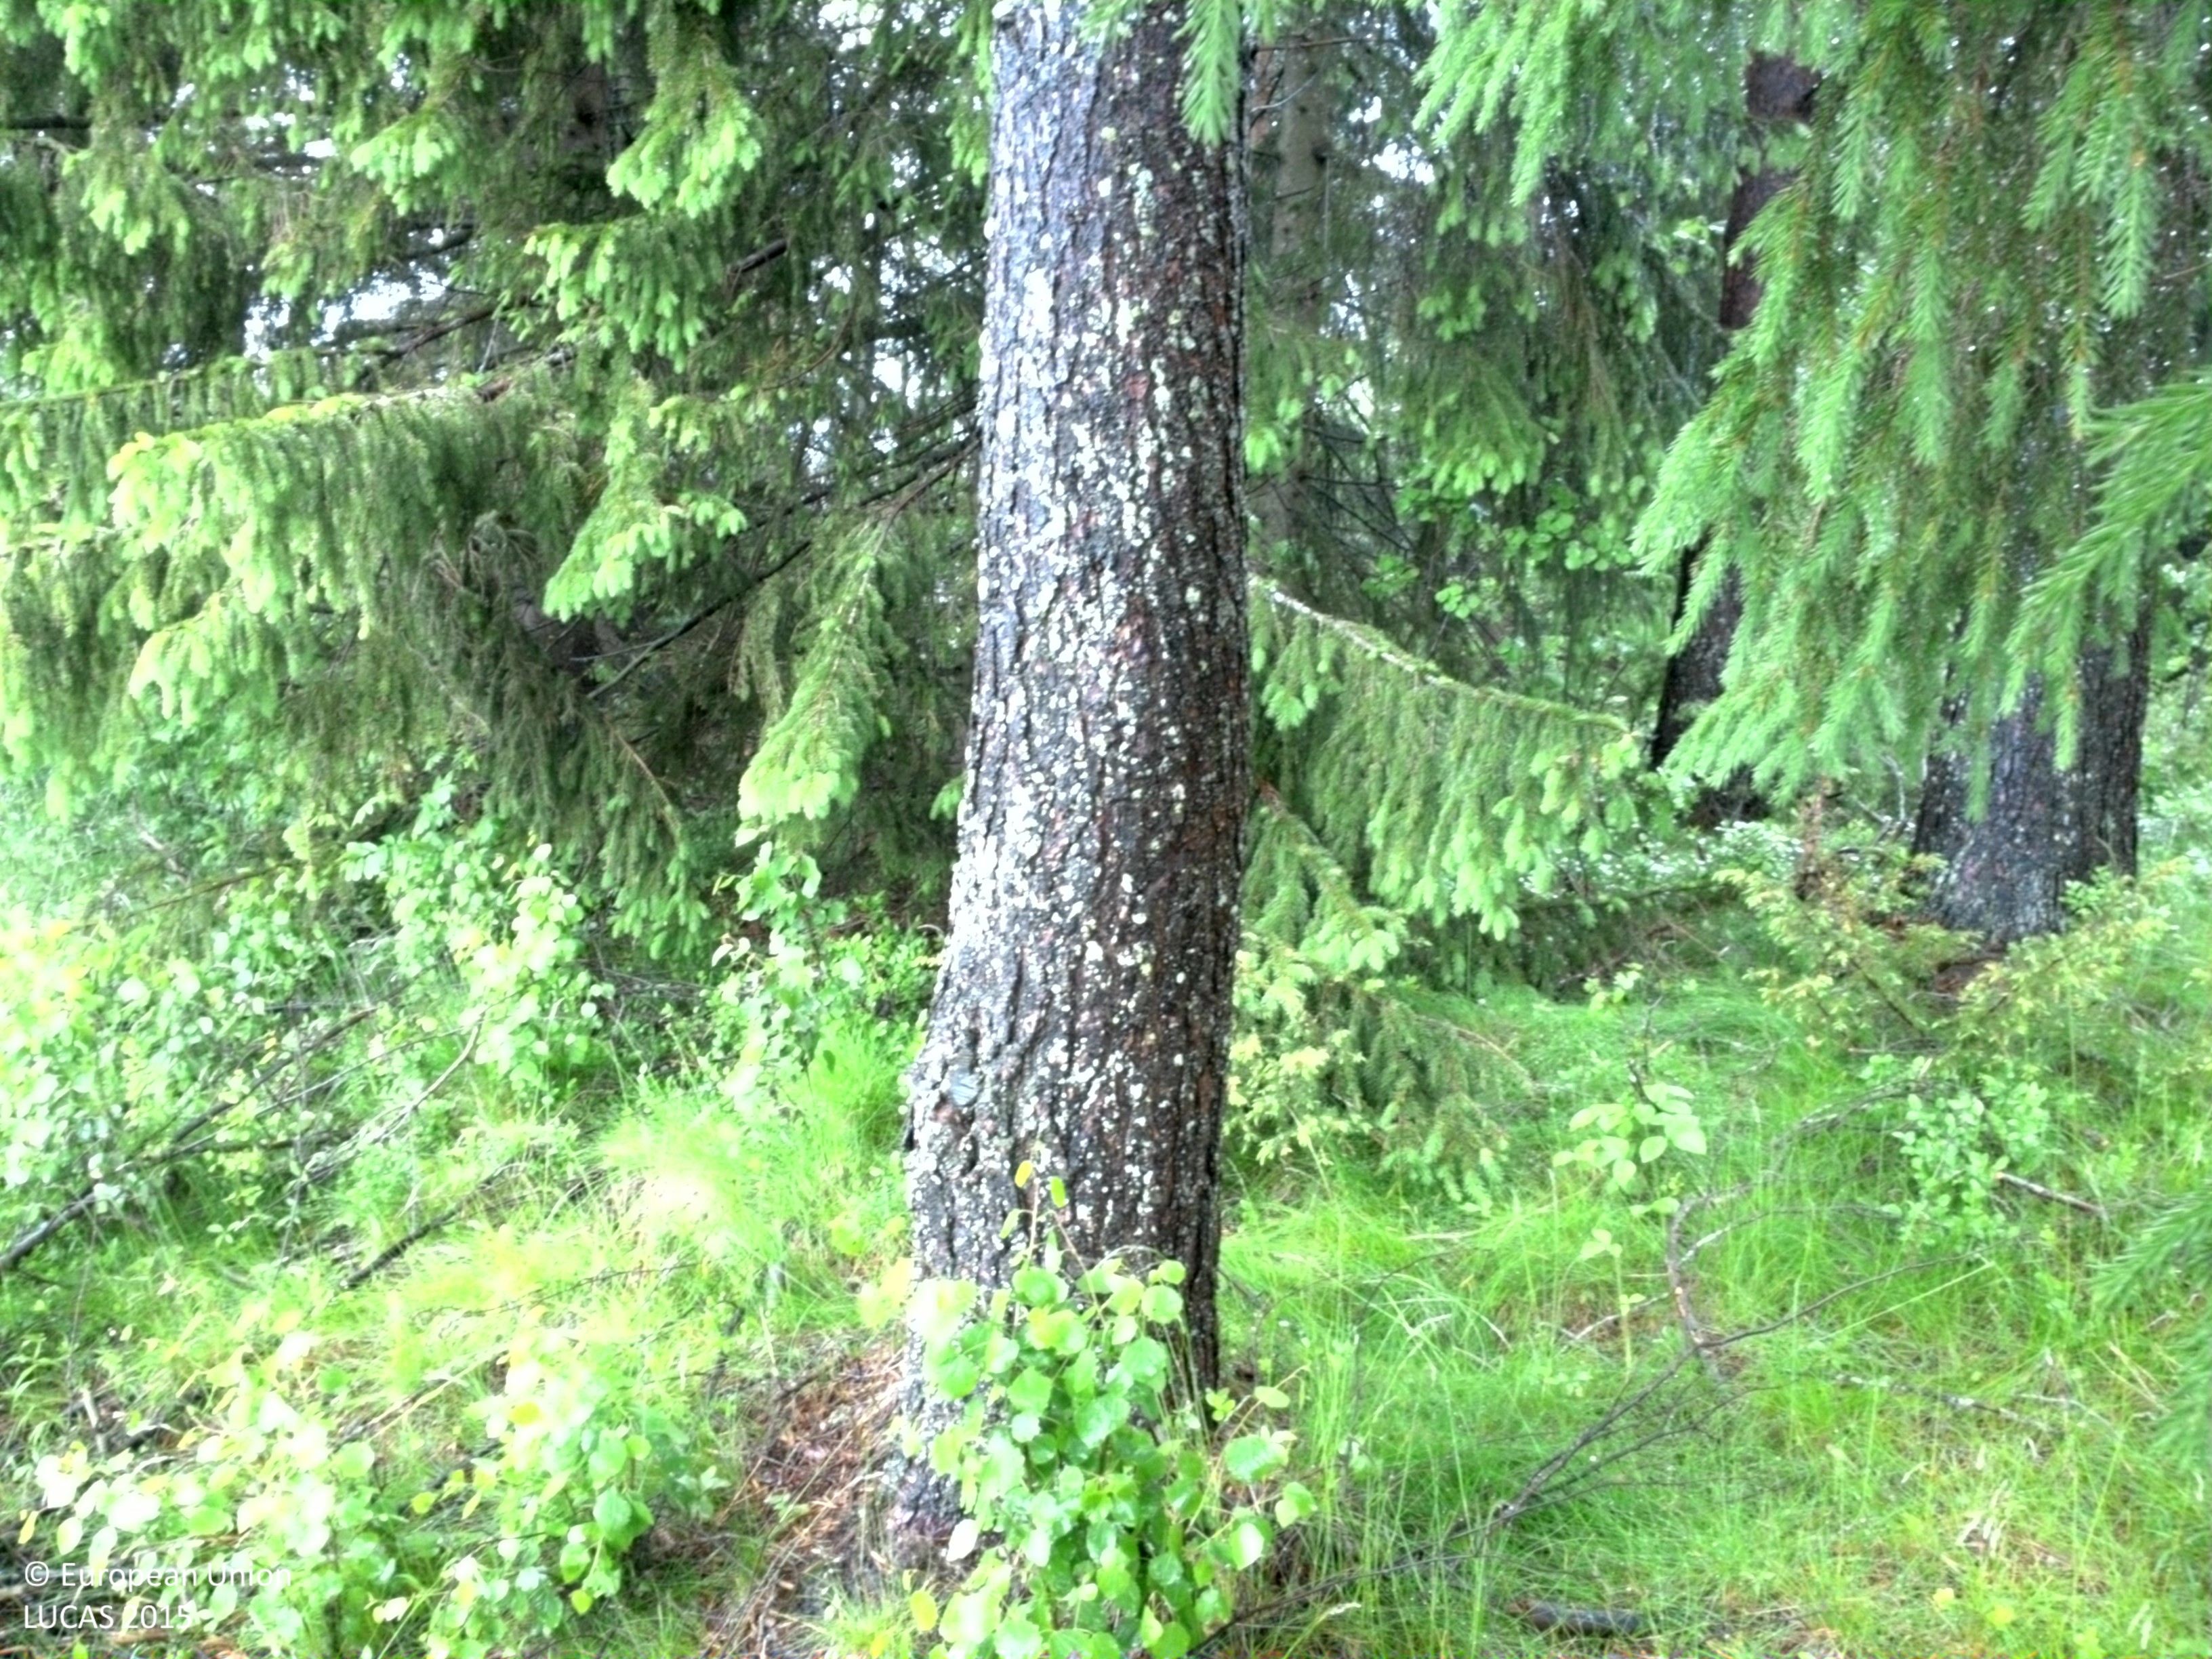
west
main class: Woodland
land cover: Spruce dominated coniferous woodland
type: boreal forest
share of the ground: 50 - 75 %
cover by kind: coniferous forest trees 65 %, shrubs 25 %, broadleaved forest trees 5 %, herbaceous plants 5 %
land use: Forestry
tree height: > 5 m
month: June
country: SE
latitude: 64.3361
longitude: 20.8460
